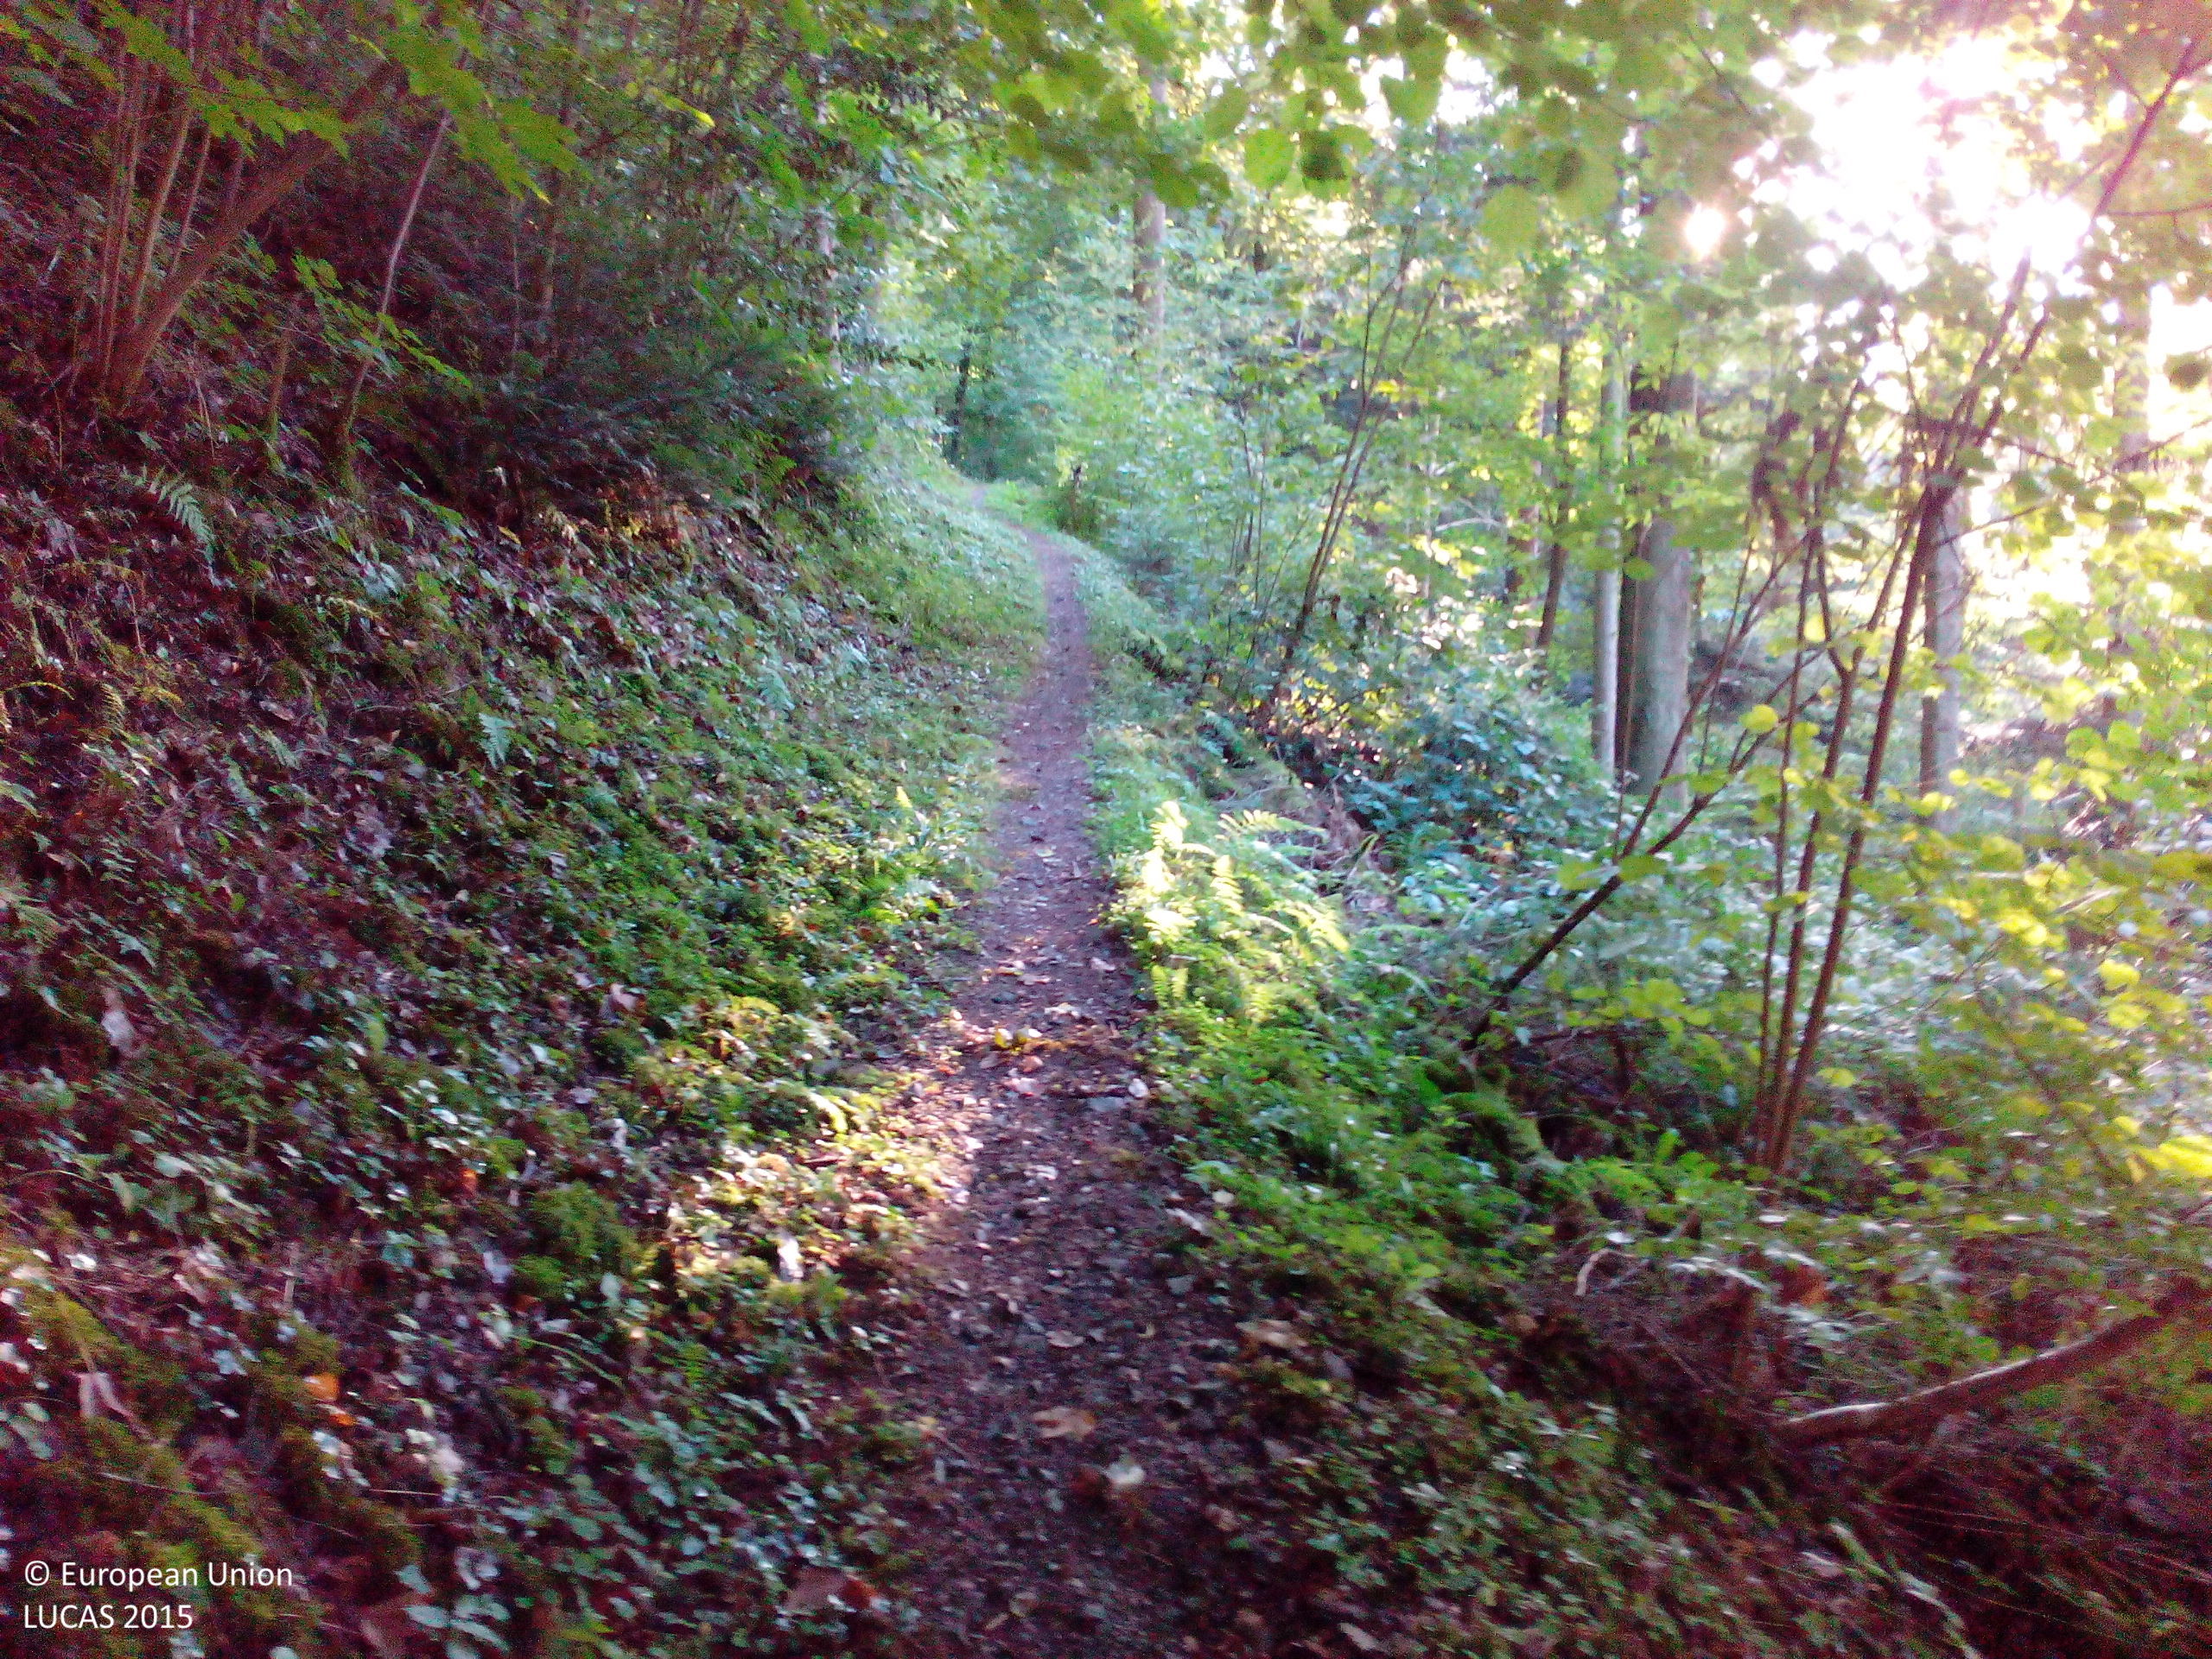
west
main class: Woodland
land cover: Spruce dominated mixed woodland
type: hemiboreal forest and nemoral coniferous forest and mixed broadleaved-coniferous forest
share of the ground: 50 - 75 %
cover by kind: coniferous forest trees 50 %, broadleaved forest trees 20 %, shrubs 10 %, herbaceous plants 10 %, lichens and mosses 10 %
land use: Forestry
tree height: > 5 m
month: September
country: DE
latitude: 48.2796
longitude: 8.1278
